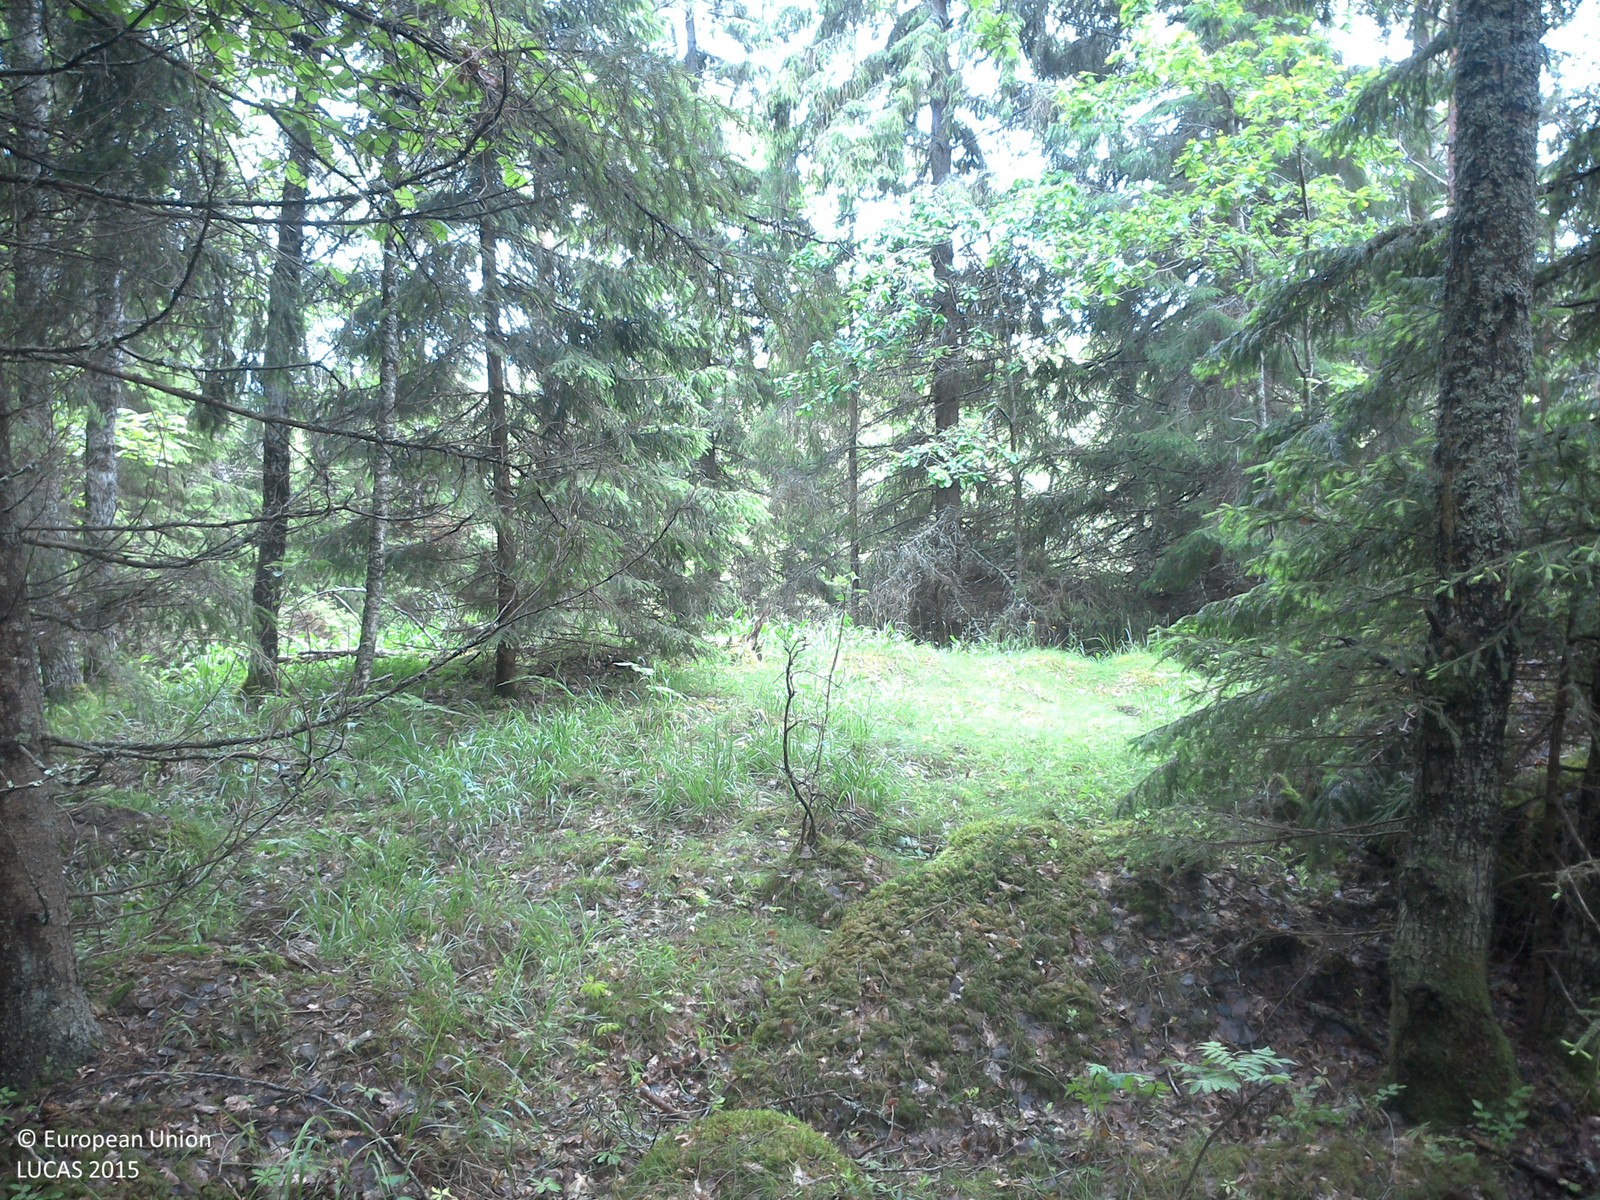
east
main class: Woodland
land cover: Spruce dominated coniferous woodland
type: boreal forest
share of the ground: > 75 %
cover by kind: coniferous forest trees 75 %, lichens and mosses 25 %
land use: Forestry
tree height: > 5 m
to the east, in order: Spruce dominated coniferous woodland; Rivers and streams; Spruce dominated coniferous woodland
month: June
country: SE
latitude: 58.0859
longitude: 15.5752
